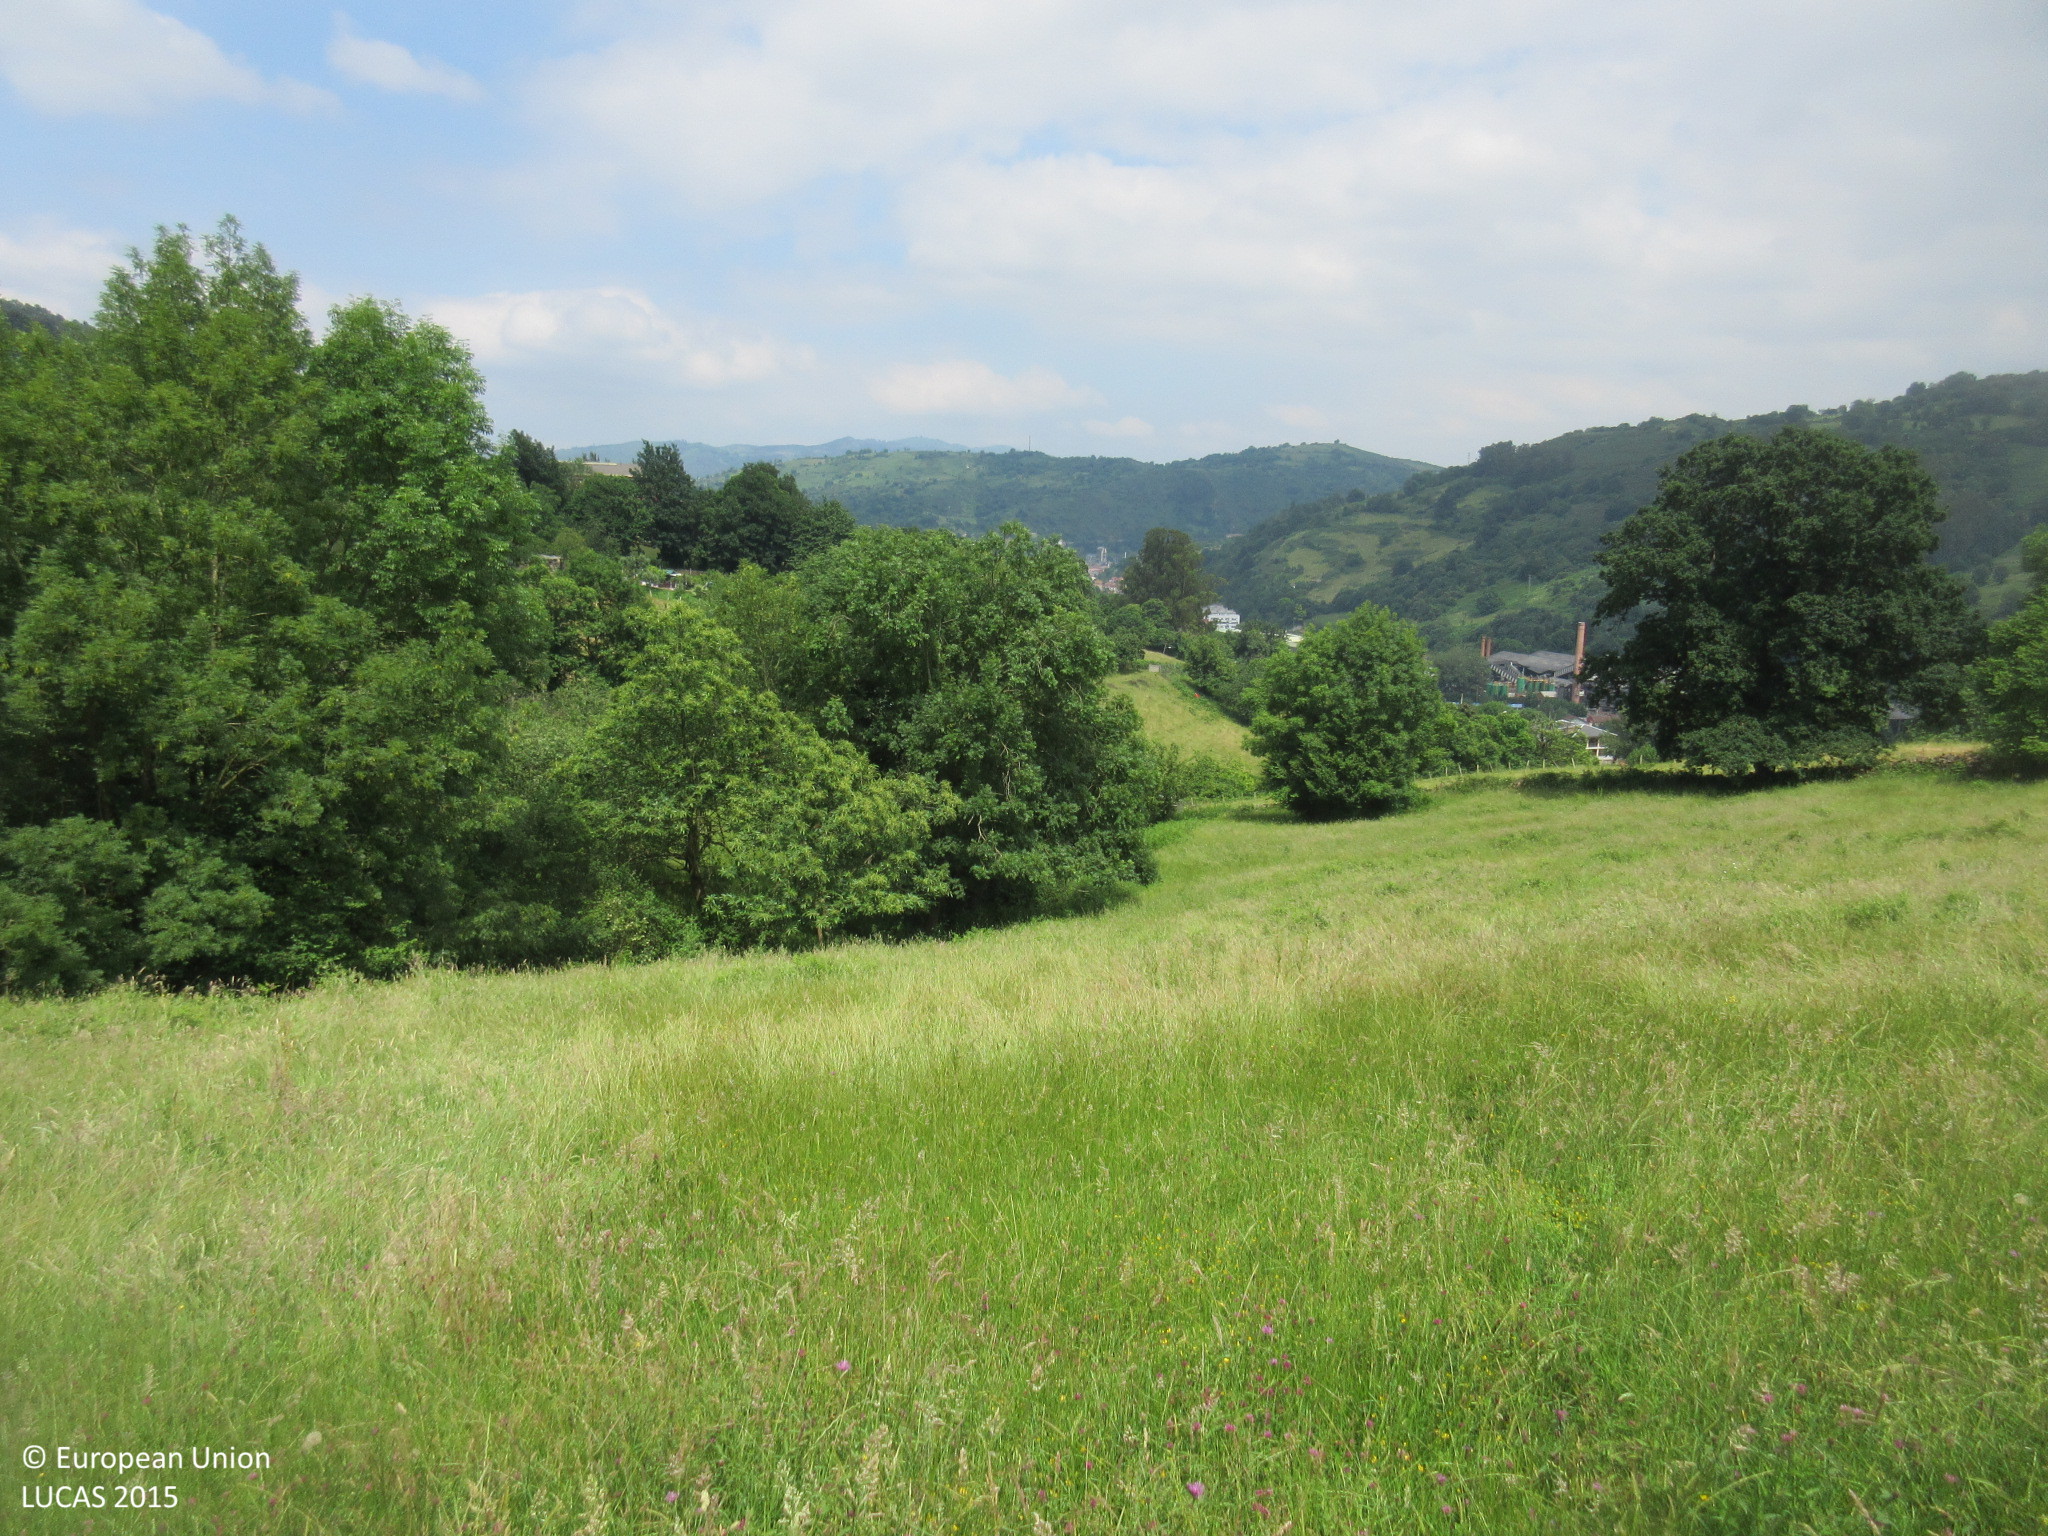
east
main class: Grassland
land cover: Grassland without tree/shrub cover
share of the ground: > 75 %
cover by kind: herbaceous plants 100 %
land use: Agriculture (excluding fallow land and kitchen gardens)
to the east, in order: Grassland without tree/shrub cover; Single bushes/trees; Dry stone walls; Grassland without tree/shrub cover; Fences; Single bushes/trees; Grassland without tree/shrub cover
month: June
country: ES
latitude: 43.3396
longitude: -5.9903
